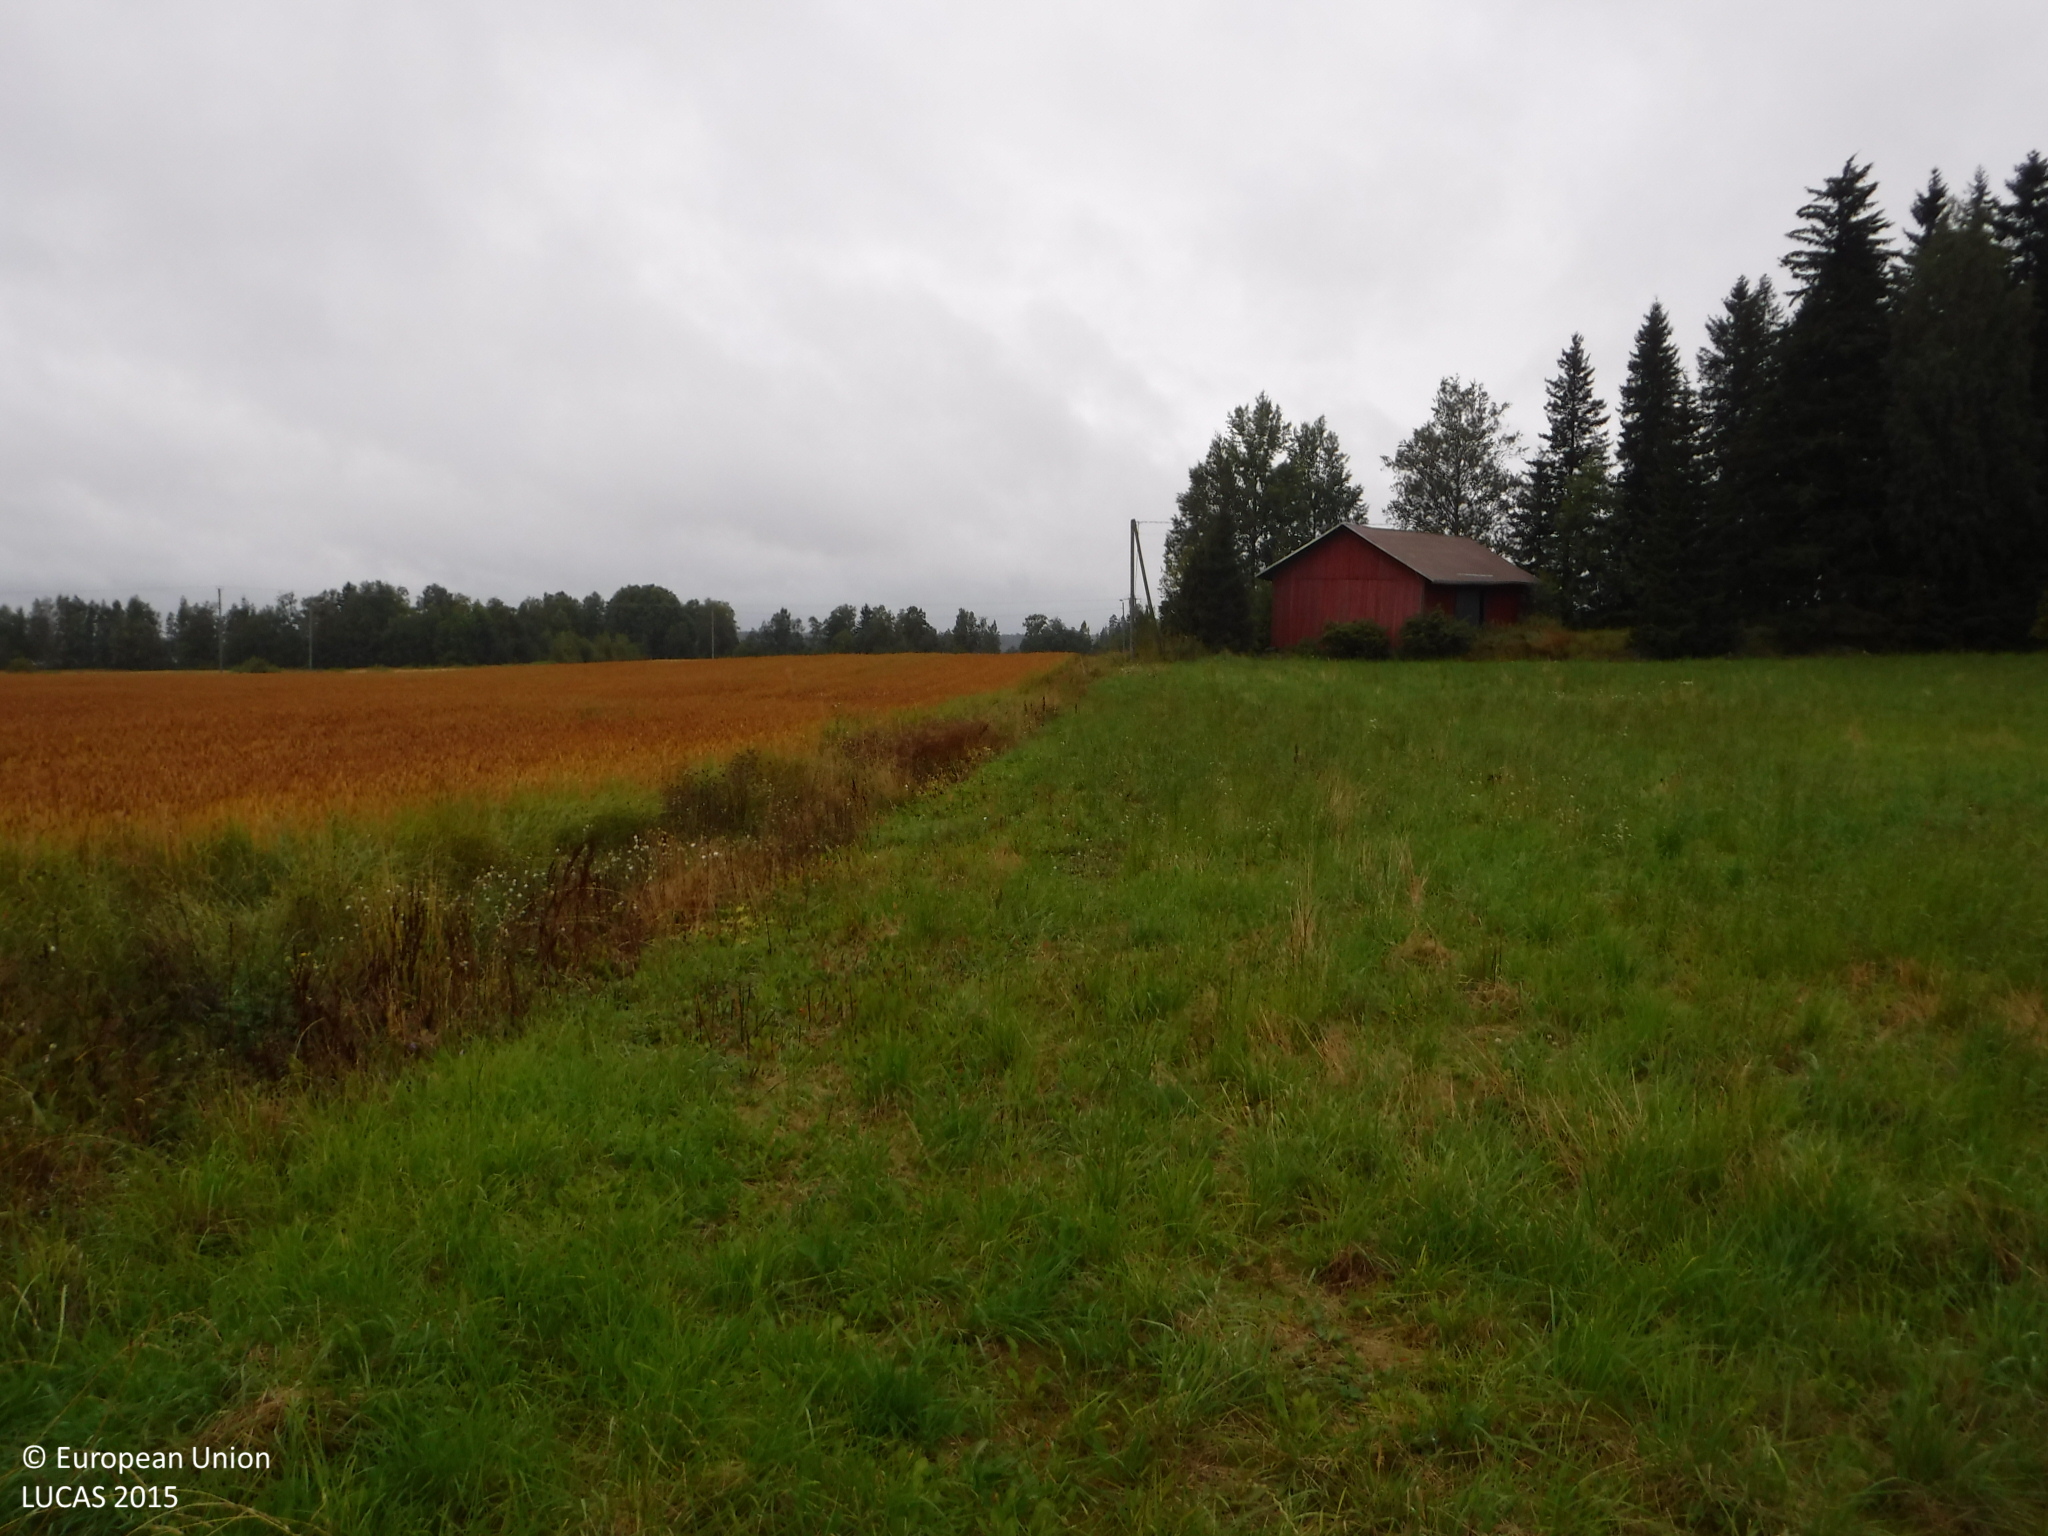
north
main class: Cropland
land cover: Temporary grasslands
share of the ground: > 75 %
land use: Agriculture (excluding fallow land and kitchen gardens)
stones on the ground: < 10 %
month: September
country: FI
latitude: 61.3331
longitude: 22.9845
